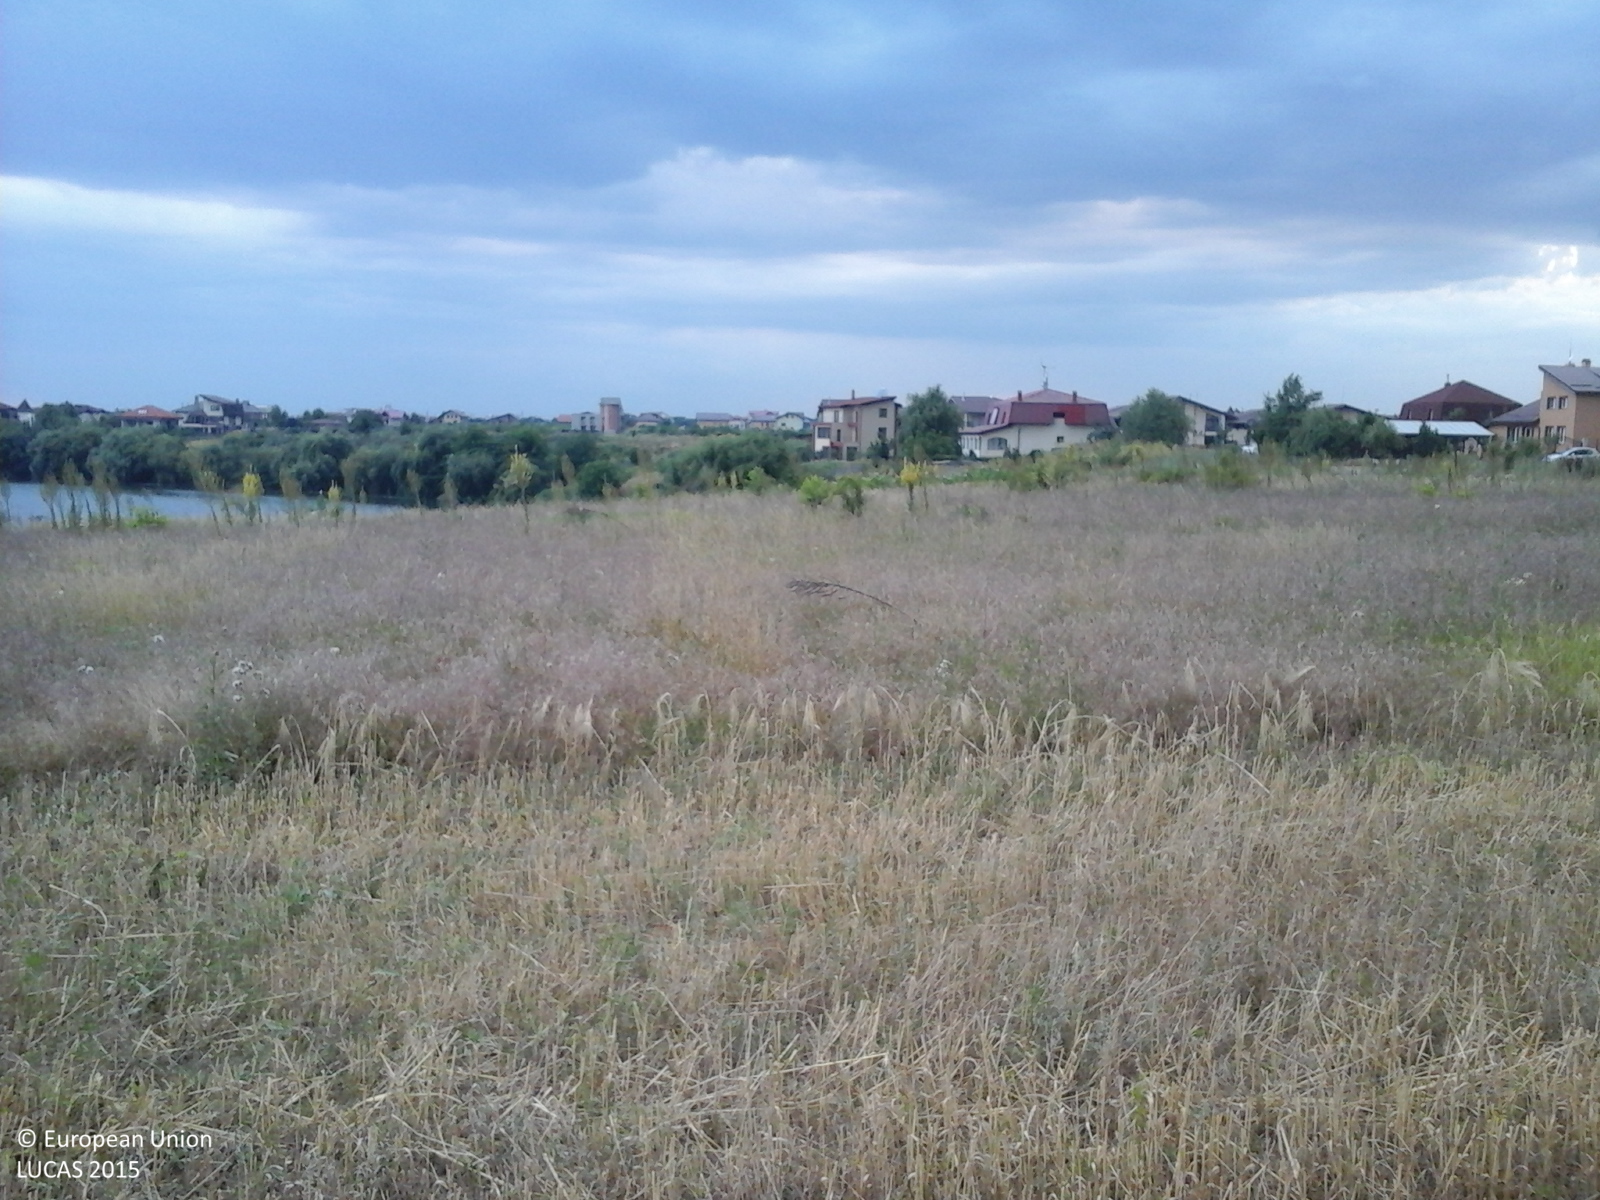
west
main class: Cropland
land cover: Common wheat
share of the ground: < 10 %
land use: Agriculture (excluding fallow land and kitchen gardens)
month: June
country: RO
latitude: 44.4404
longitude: 26.2281
